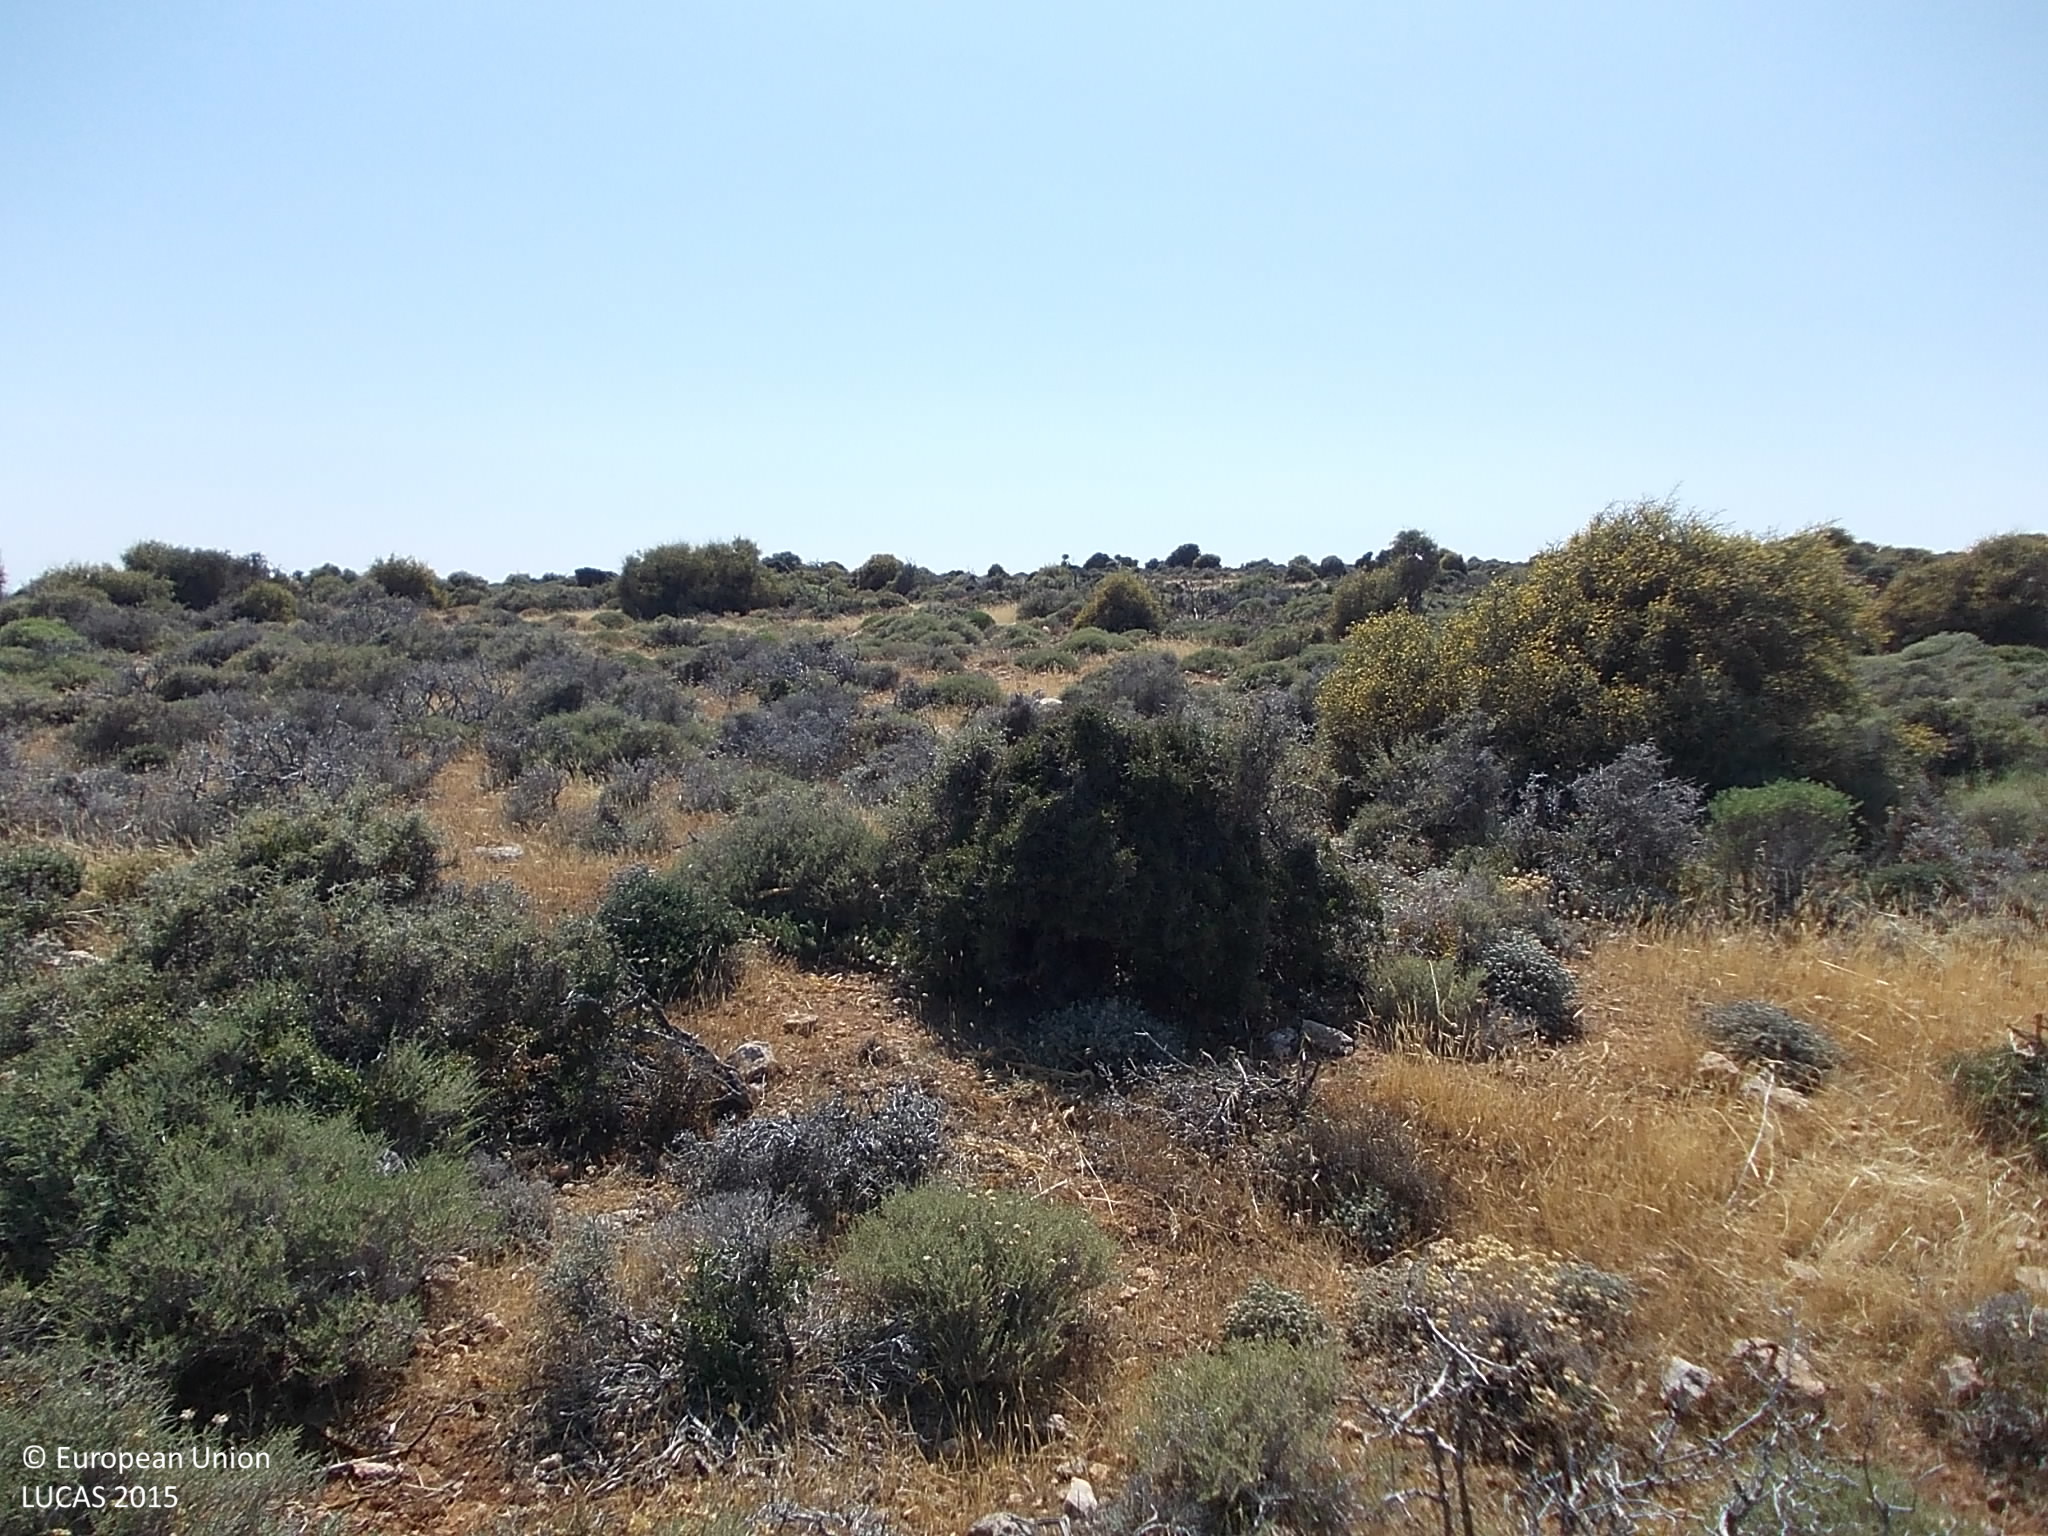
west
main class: Shrubland
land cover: Shrubland without tree cover
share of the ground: > 75 %
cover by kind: shrubs 75 %, unconsolidated bare surface 15 %, herbaceous plants 10 %
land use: Semi-natural and natural areas not in use
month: June
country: CY
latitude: 34.6450
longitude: 32.7012
